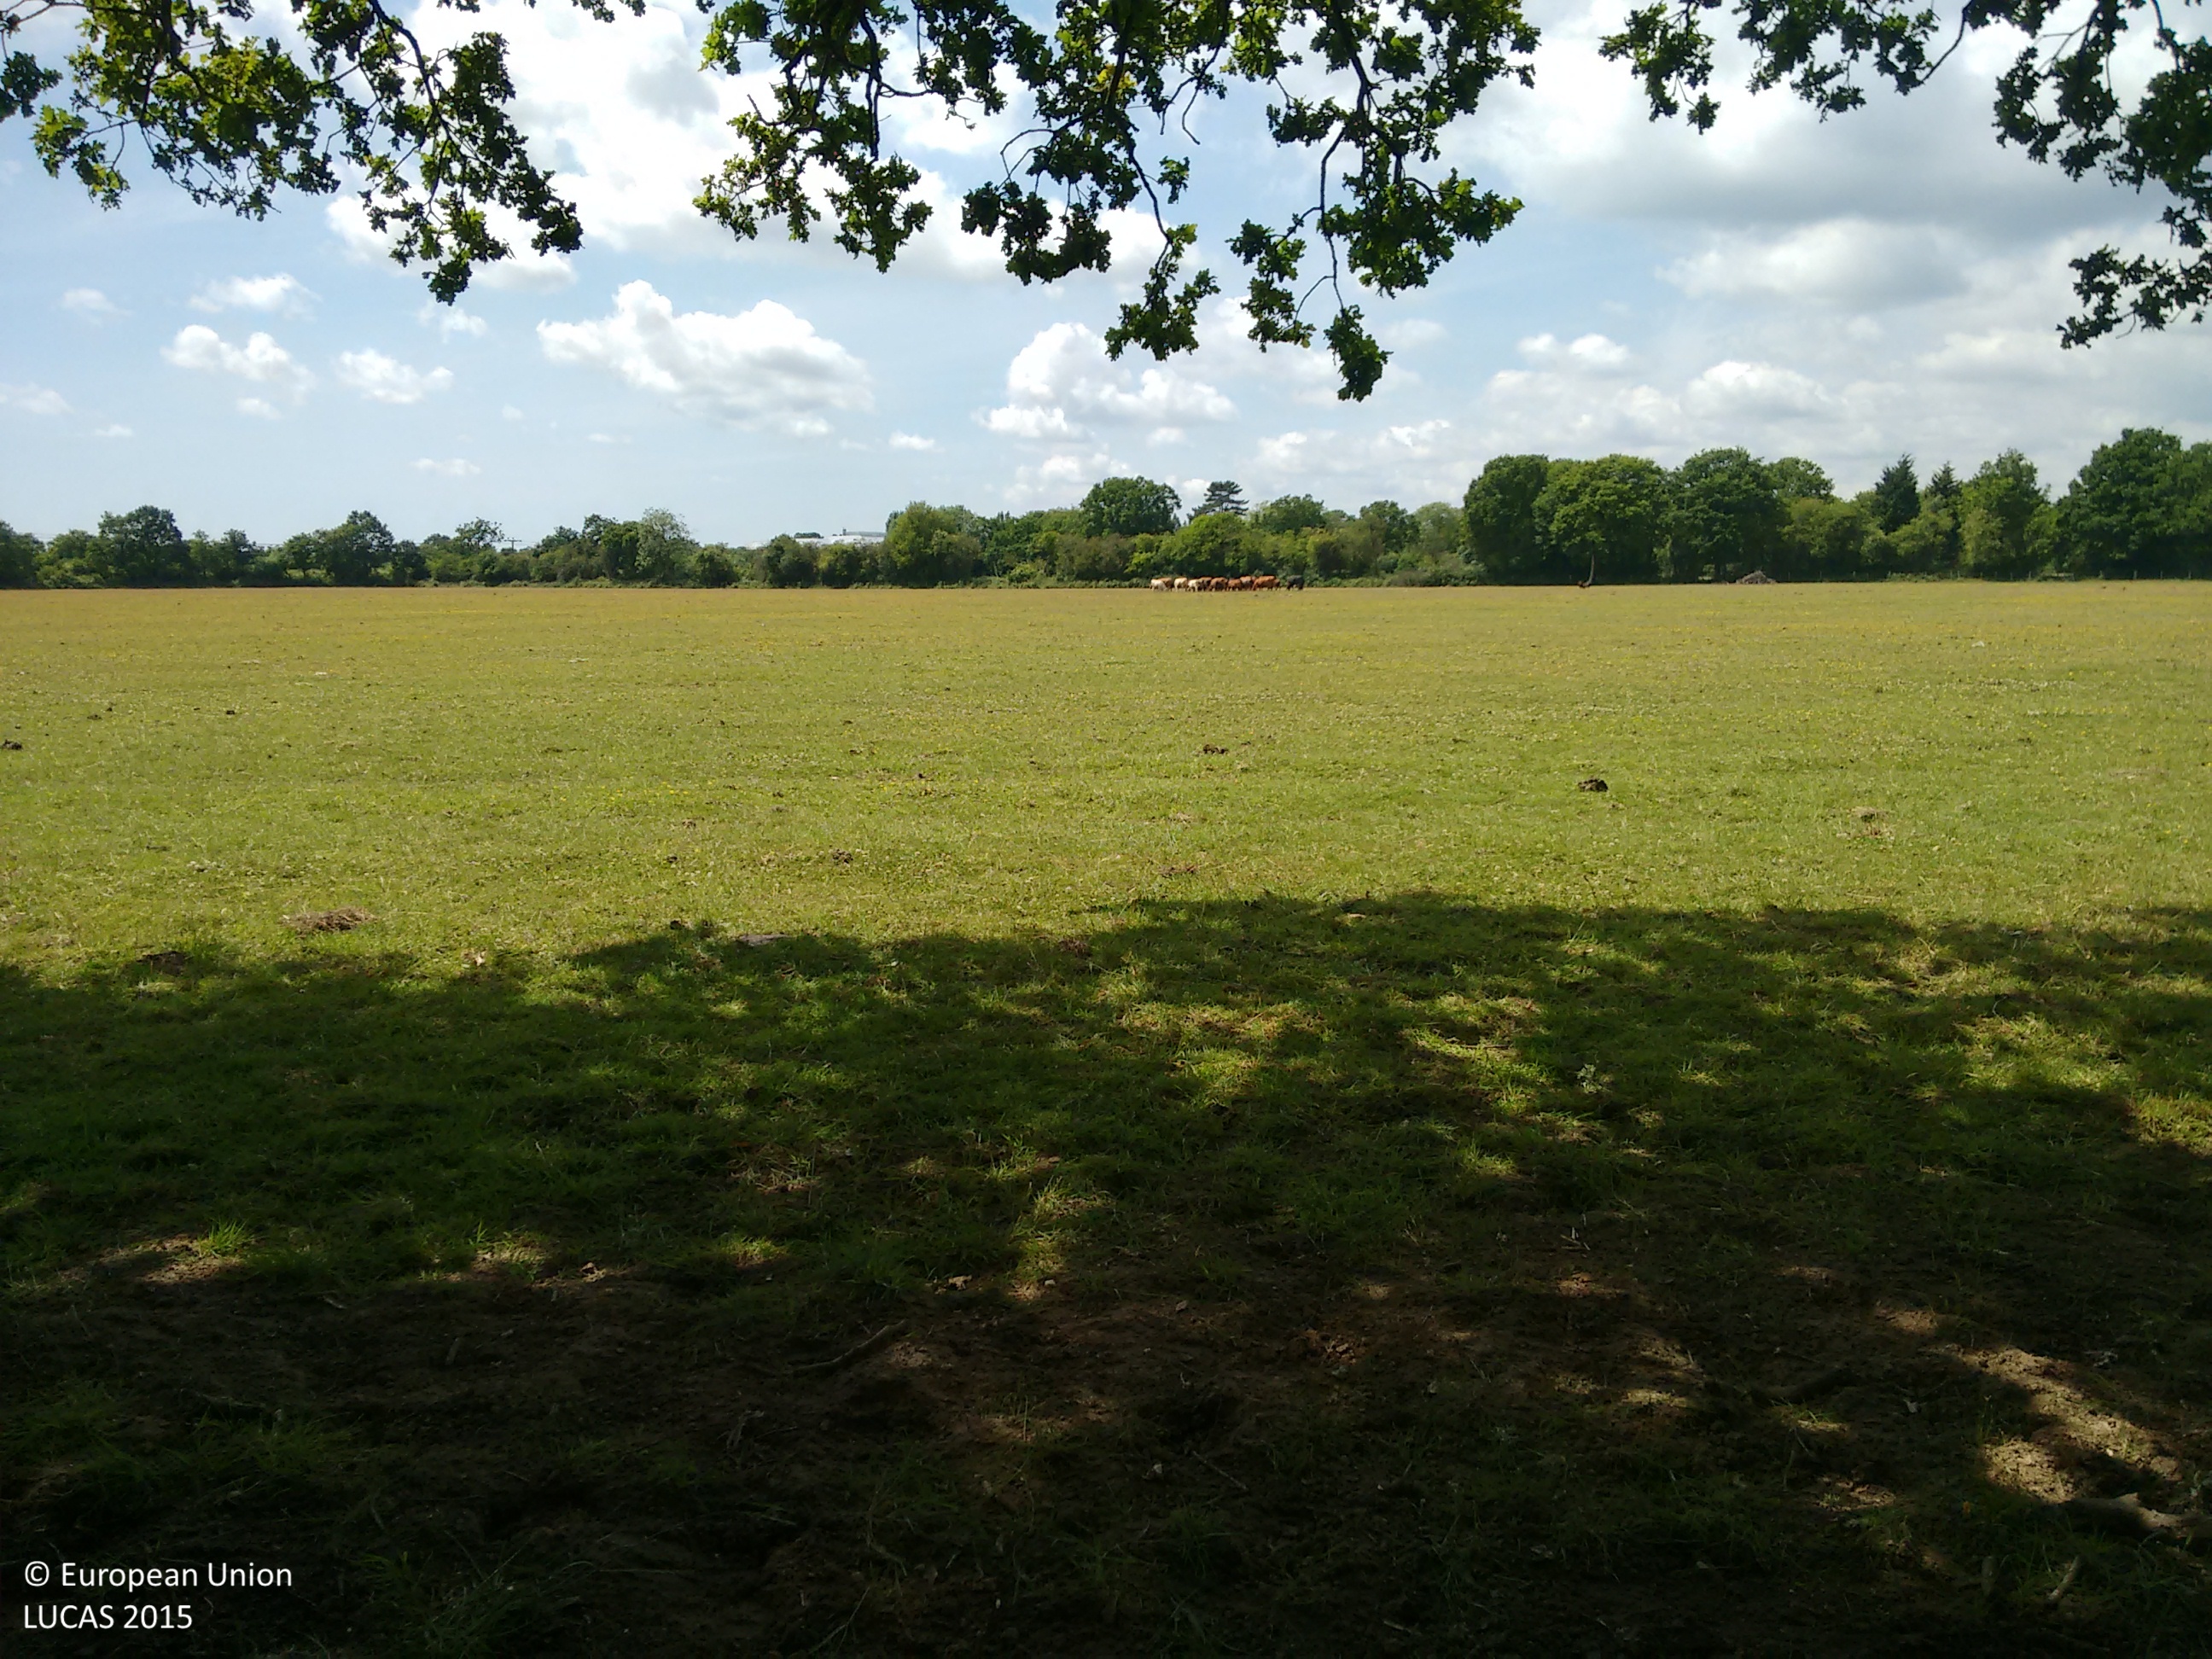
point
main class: Grassland
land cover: Grassland without tree/shrub cover
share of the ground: > 75 %
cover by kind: herbaceous plants 100 %
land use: Agriculture (excluding fallow land and kitchen gardens)
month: June
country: GB
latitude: 51.1625
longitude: -0.1444
